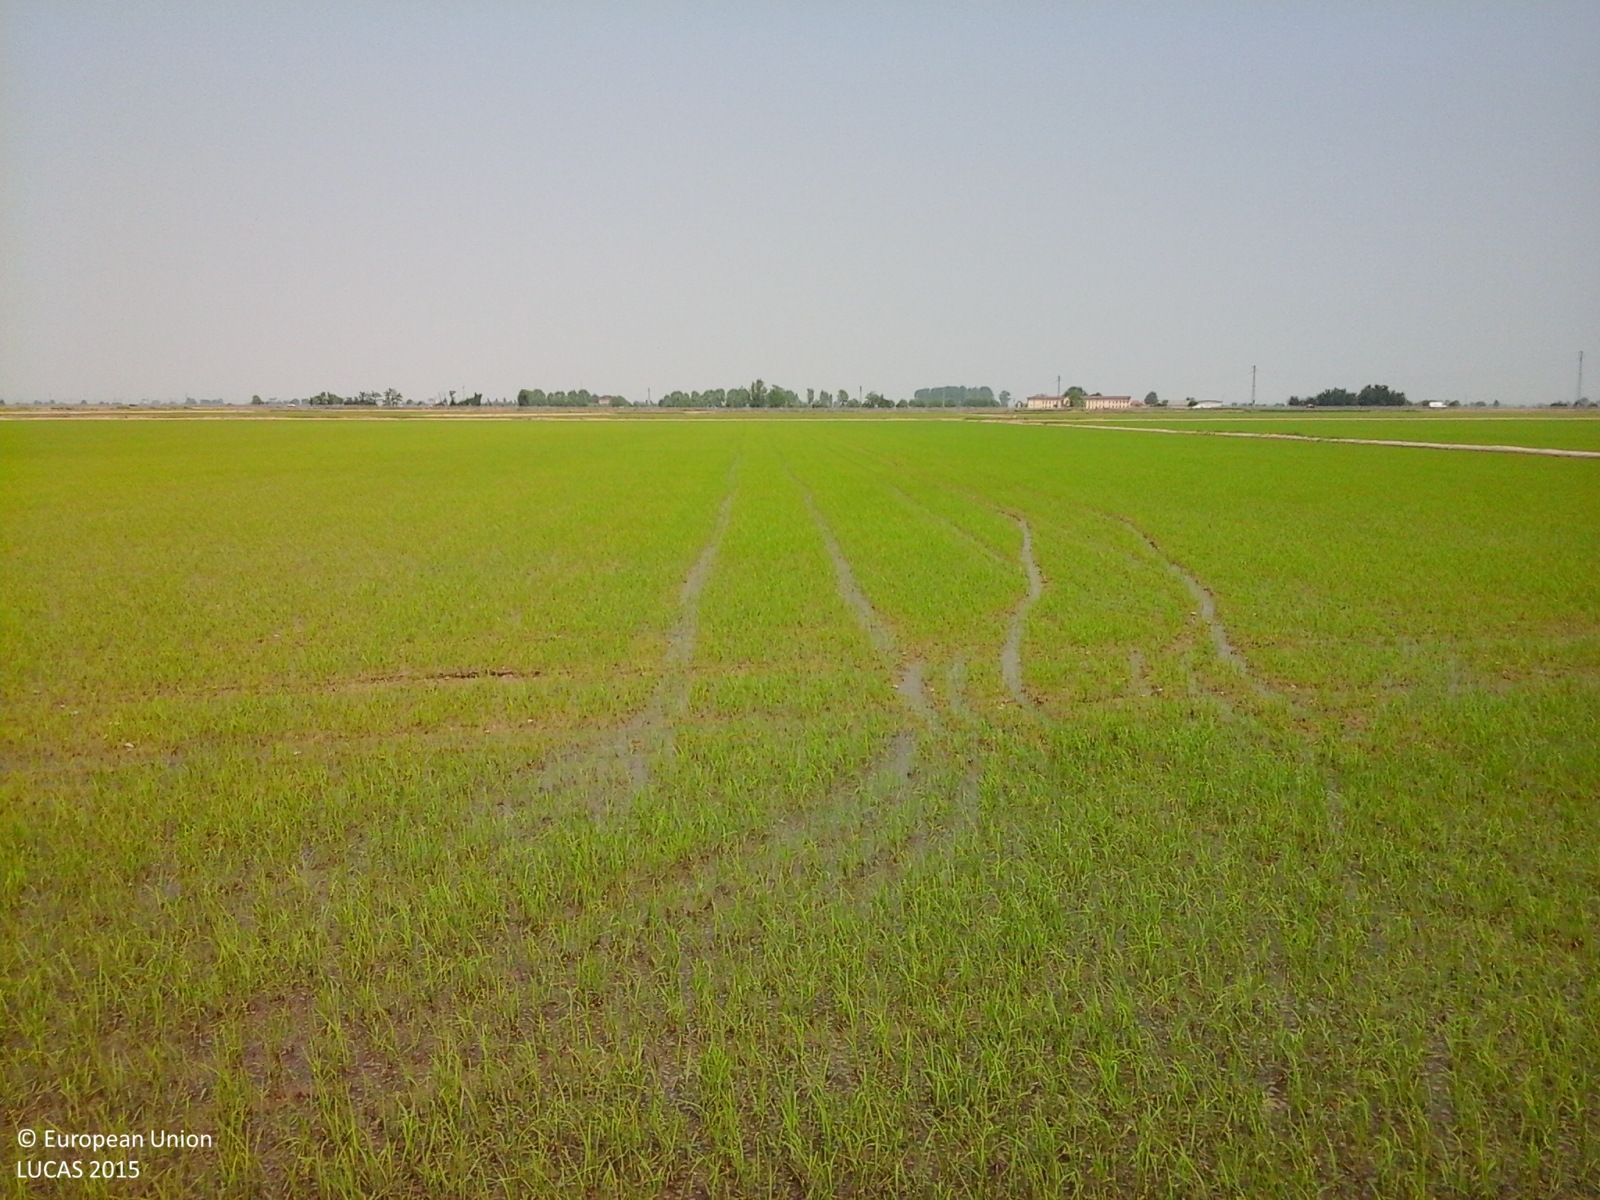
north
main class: Cropland
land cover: Rice
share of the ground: 25 - 50 %
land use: Agriculture (excluding fallow land and kitchen gardens)
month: May
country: IT
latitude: 45.3286
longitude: 8.3060
